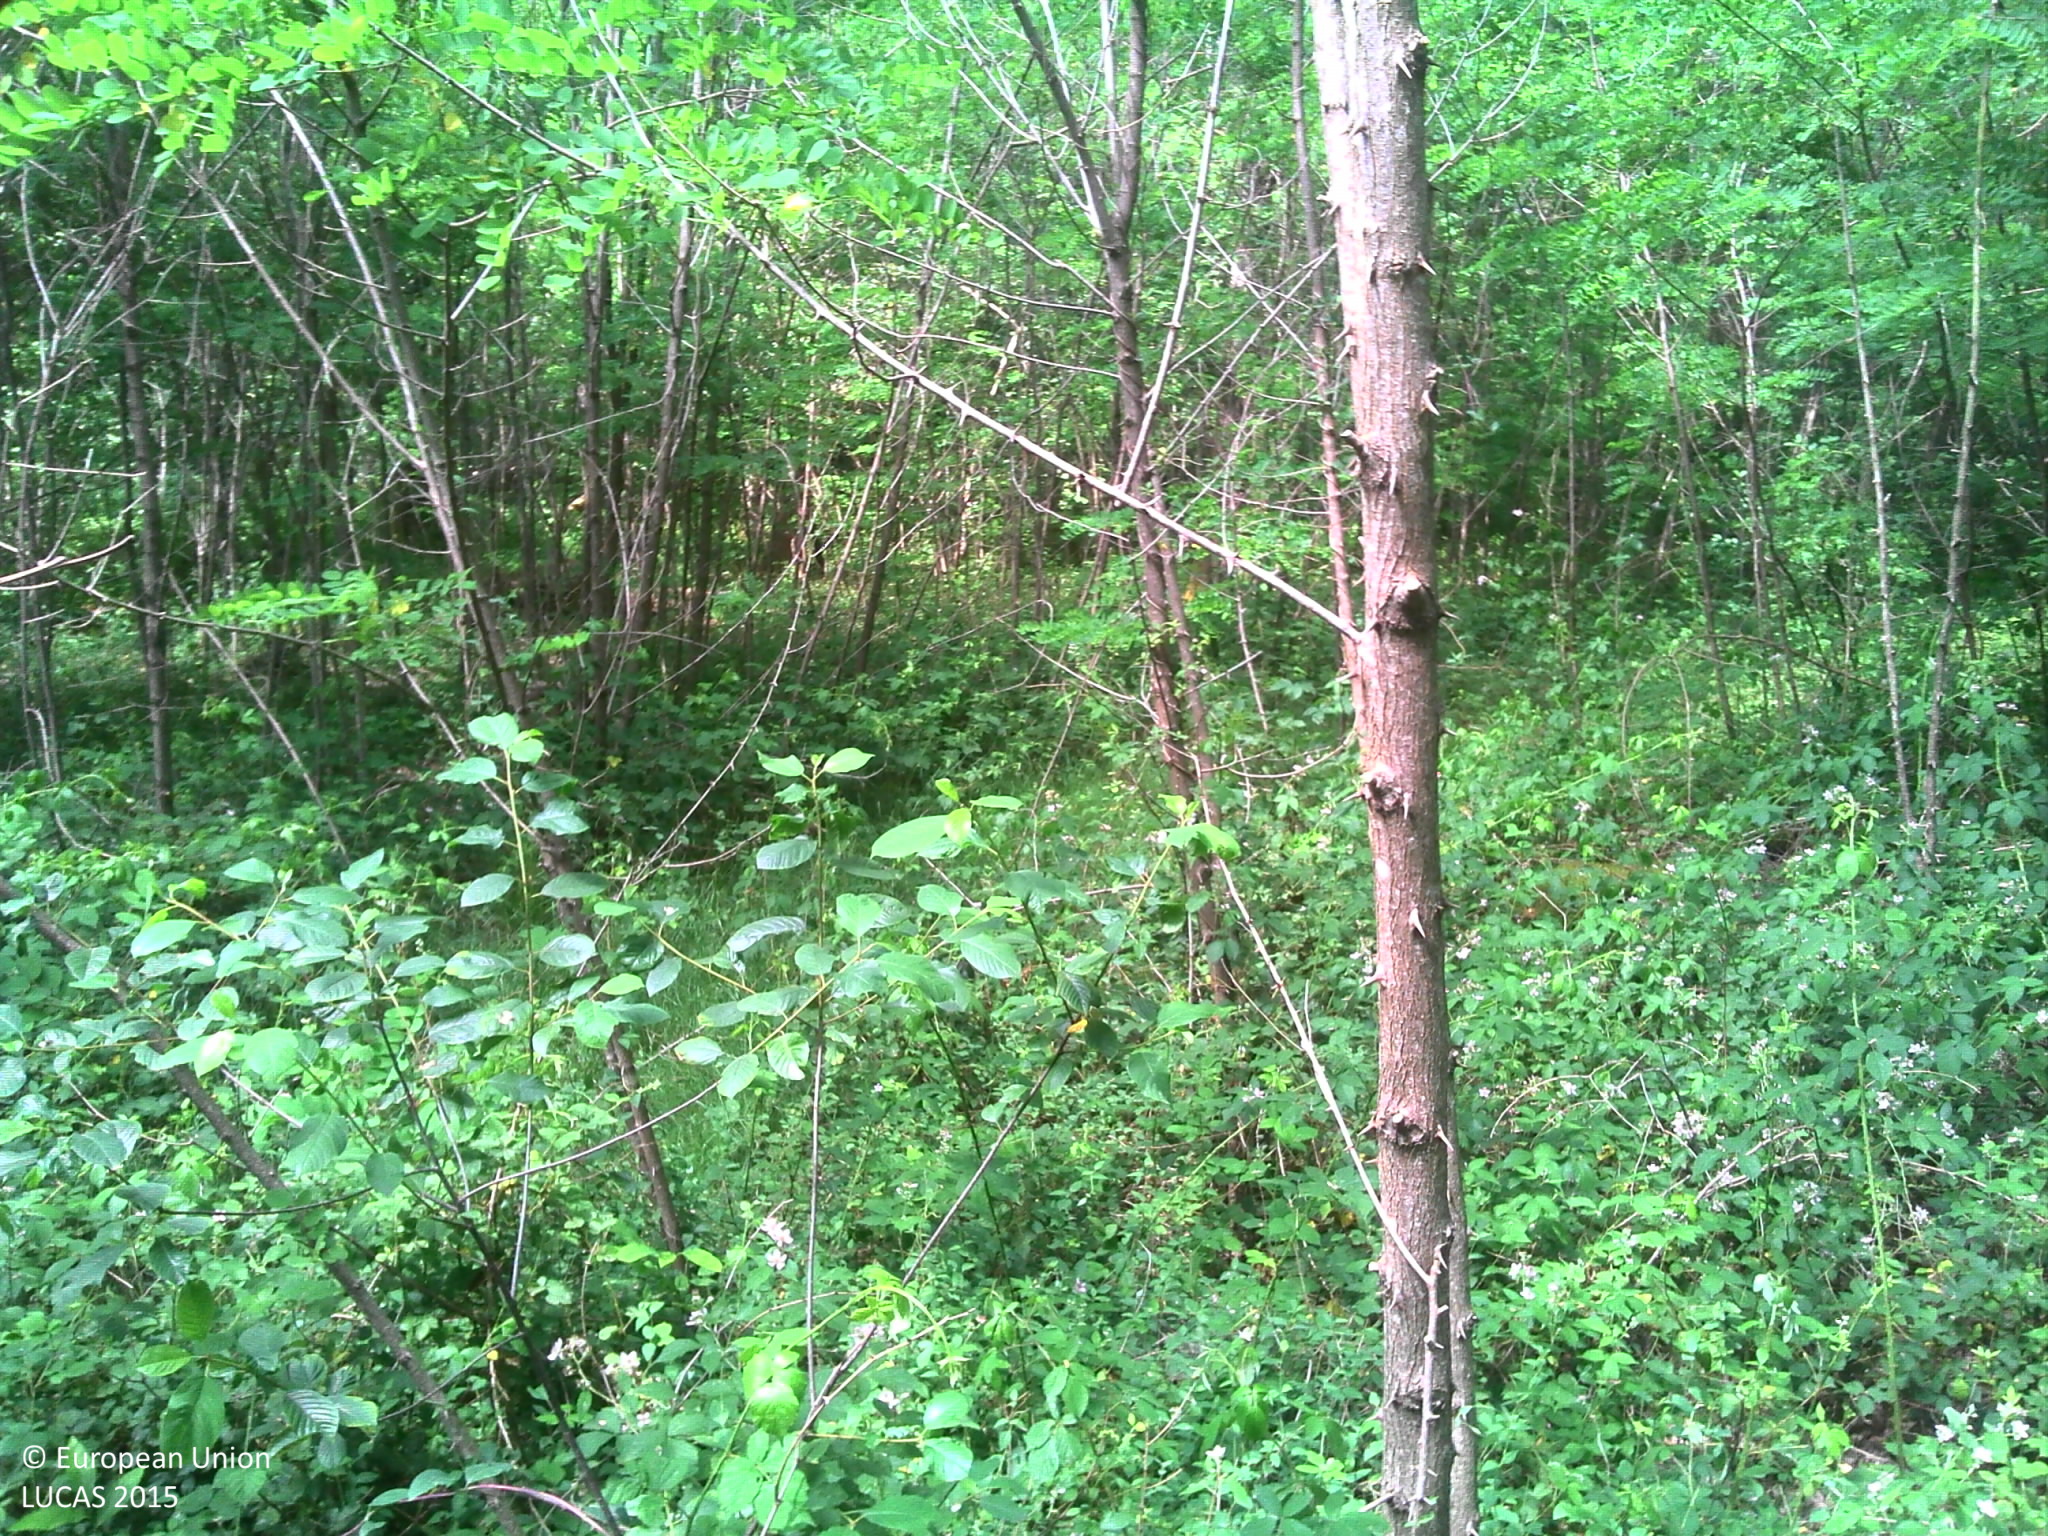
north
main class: Woodland
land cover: Broadleaved woodland
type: mesophytic deciduous forest
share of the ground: > 75 %
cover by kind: herbaceous plants 50 %, broadleaved forest trees 30 %, lichens and mosses 20 %
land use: Forestry
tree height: > 5 m
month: June
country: FR
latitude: 47.6264
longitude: 2.0180
